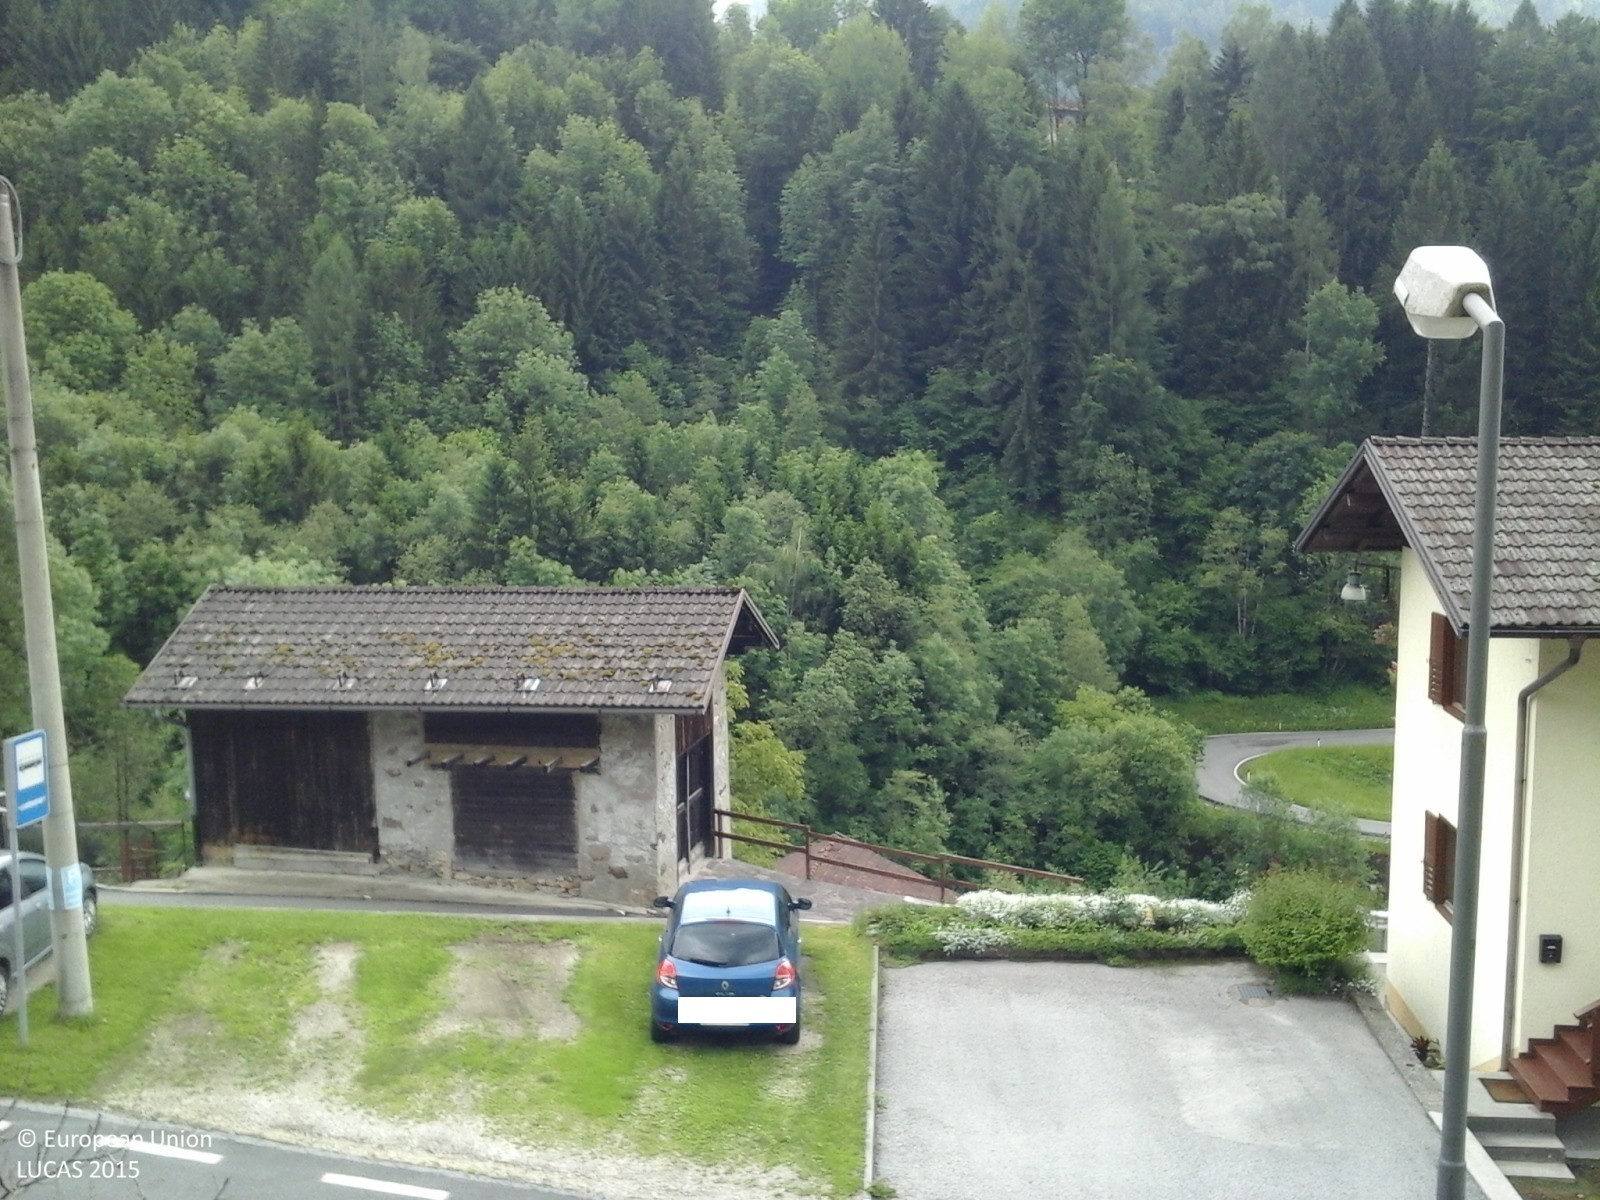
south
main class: Grassland
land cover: Grassland without tree/shrub cover
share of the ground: 50 - 75 %
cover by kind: herbaceous plants 70 %, consolidated bare surface 30 %
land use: Semi-natural and natural areas not in use
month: May
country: IT
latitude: 46.1568
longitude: 11.7458
